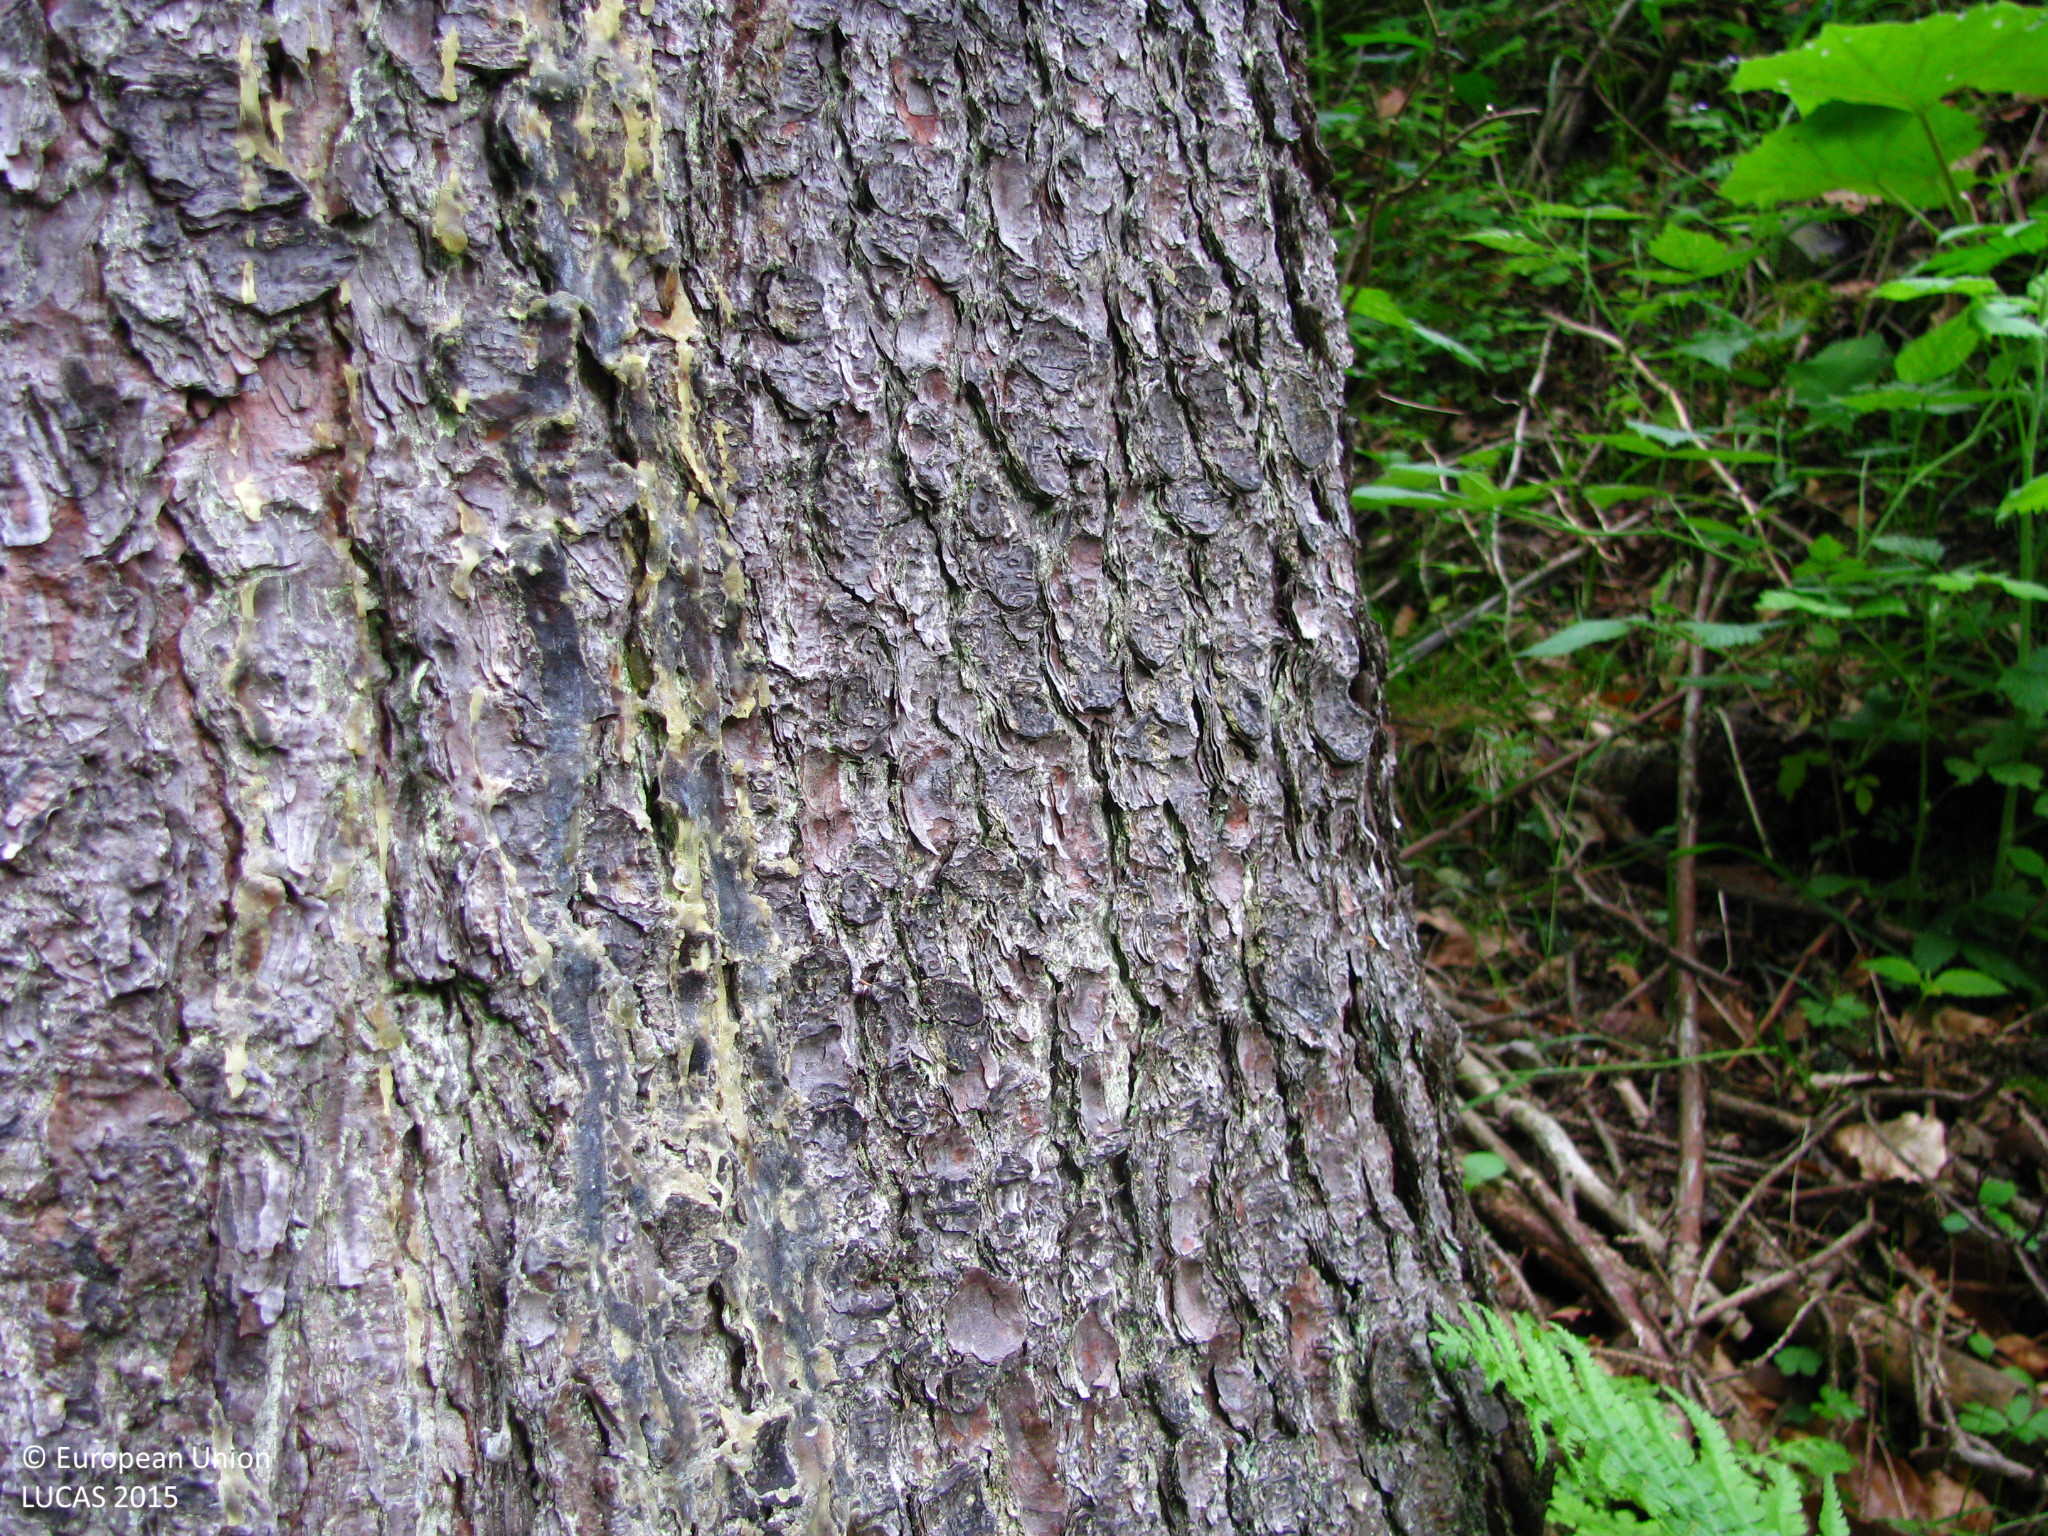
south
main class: Woodland
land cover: Spruce dominated mixed woodland
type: mountainous beech forest
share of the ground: > 75 %
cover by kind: broadleaved forest trees 45 %, coniferous forest trees 40 %, herbaceous plants 10 %, lichens and mosses 5 %
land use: Forestry
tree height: > 5 m
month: June
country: AT
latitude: 47.4622
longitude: 14.9744
